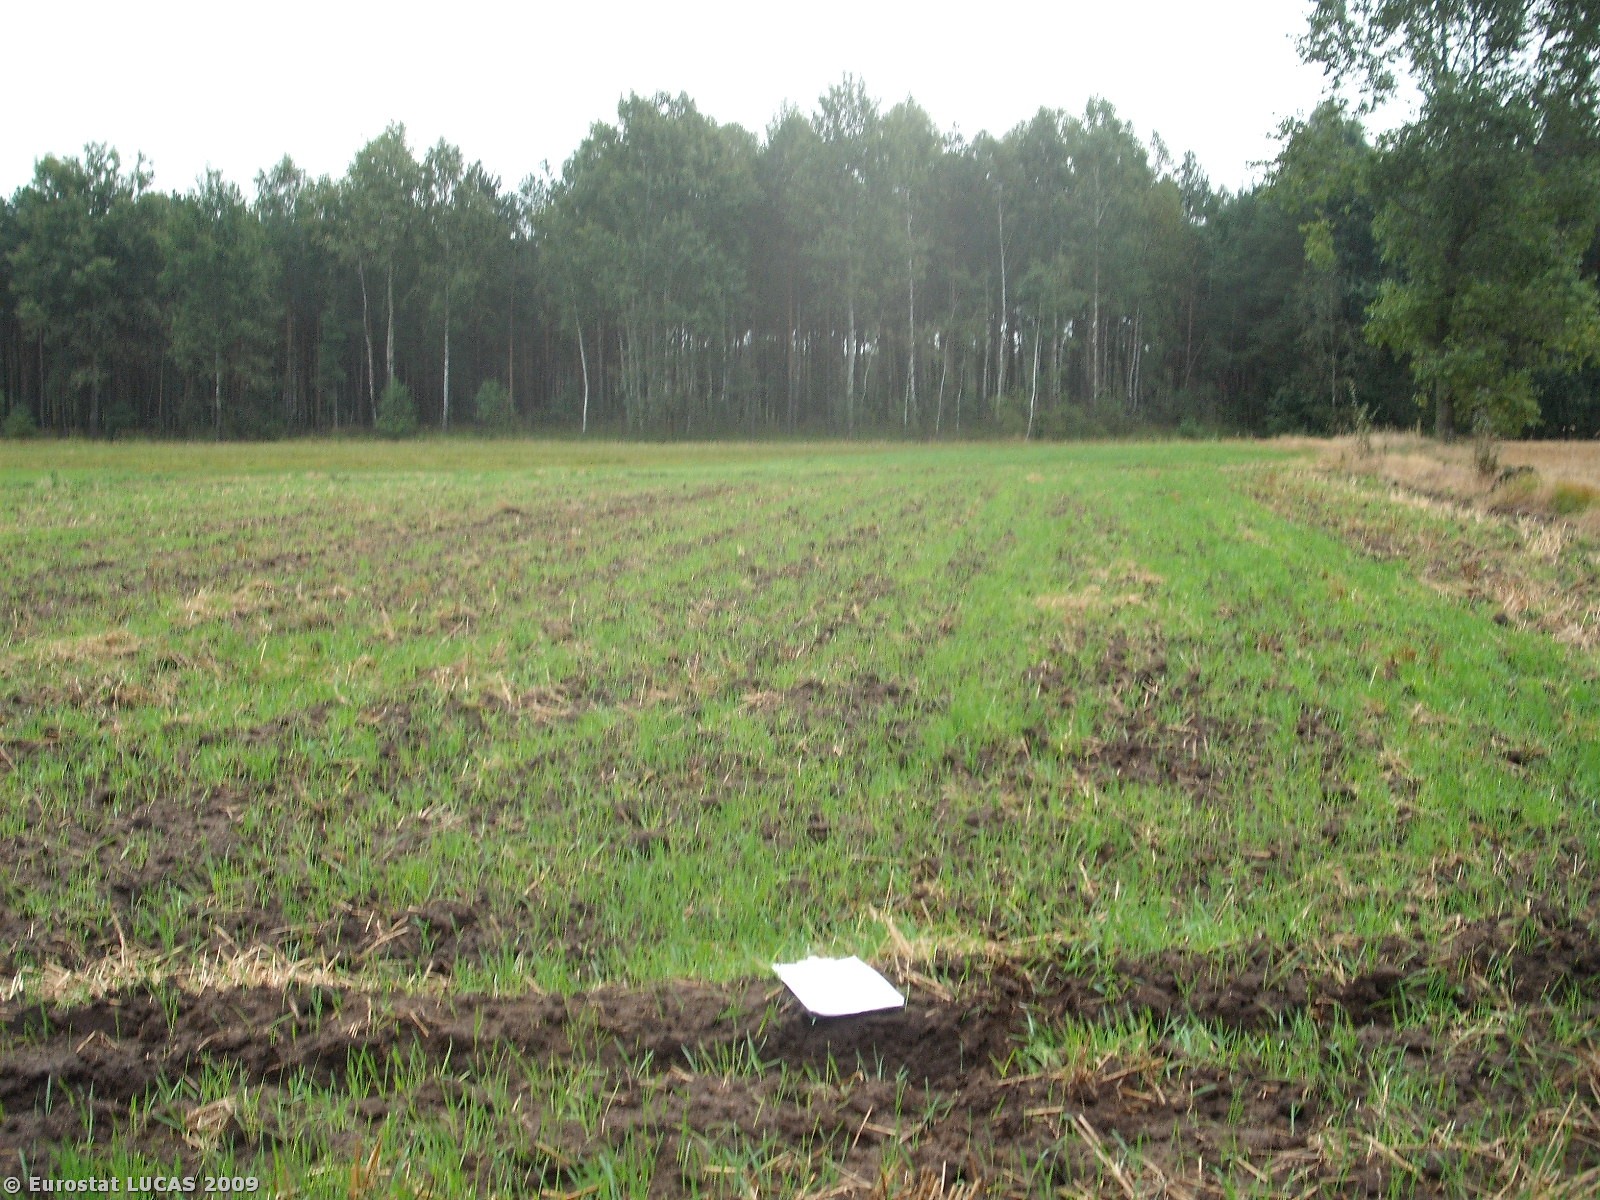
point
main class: Cropland
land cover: Mixed cereals for fodder
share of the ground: < 10 %
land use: Agriculture (excluding fallow land and kitchen gardens)
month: September
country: PL
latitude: 51.7235
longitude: 22.0605
